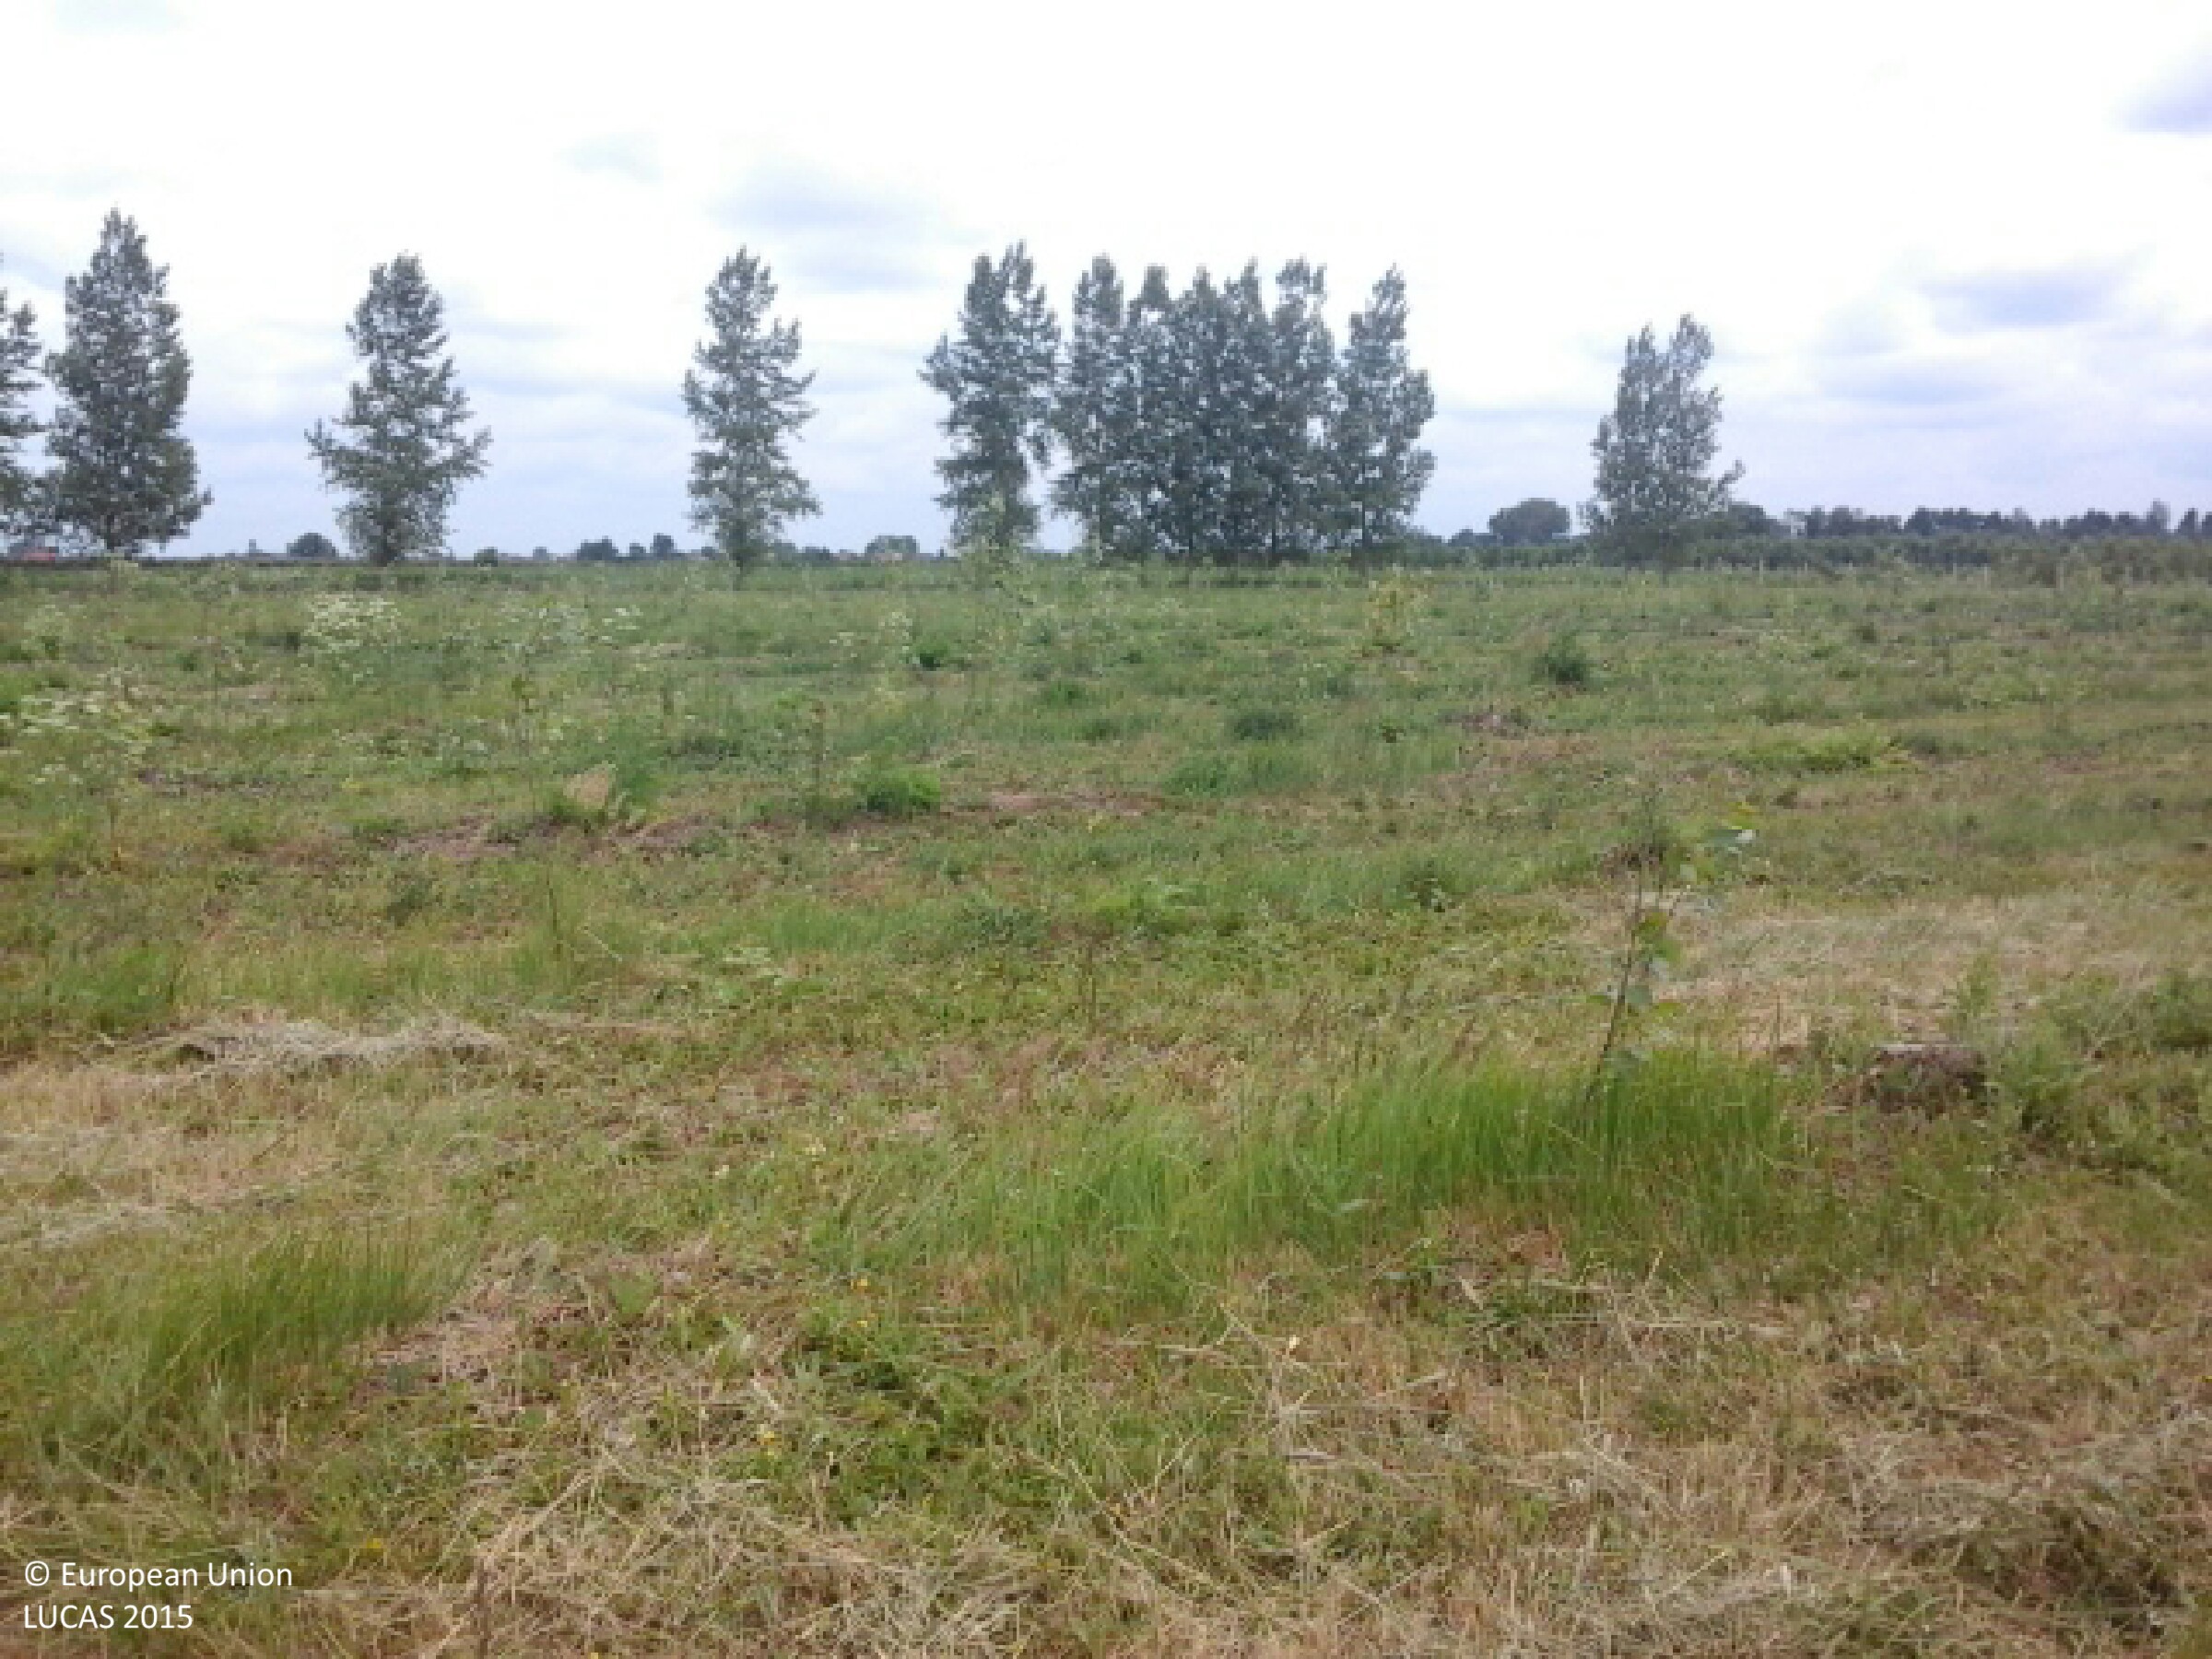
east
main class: Grassland
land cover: Grassland with sparse tree/shrub cover
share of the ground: > 75 %
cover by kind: herbaceous plants 95 %, broadleaved forest trees 5 %
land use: Agriculture (excluding fallow land and kitchen gardens)
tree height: < 5 m
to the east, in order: Grassland with sparse tree/shrub cover; Lines of trees; Ditches and canals; Grass margins; Sunflower
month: June
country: HU
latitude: 48.1732
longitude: 21.7622
